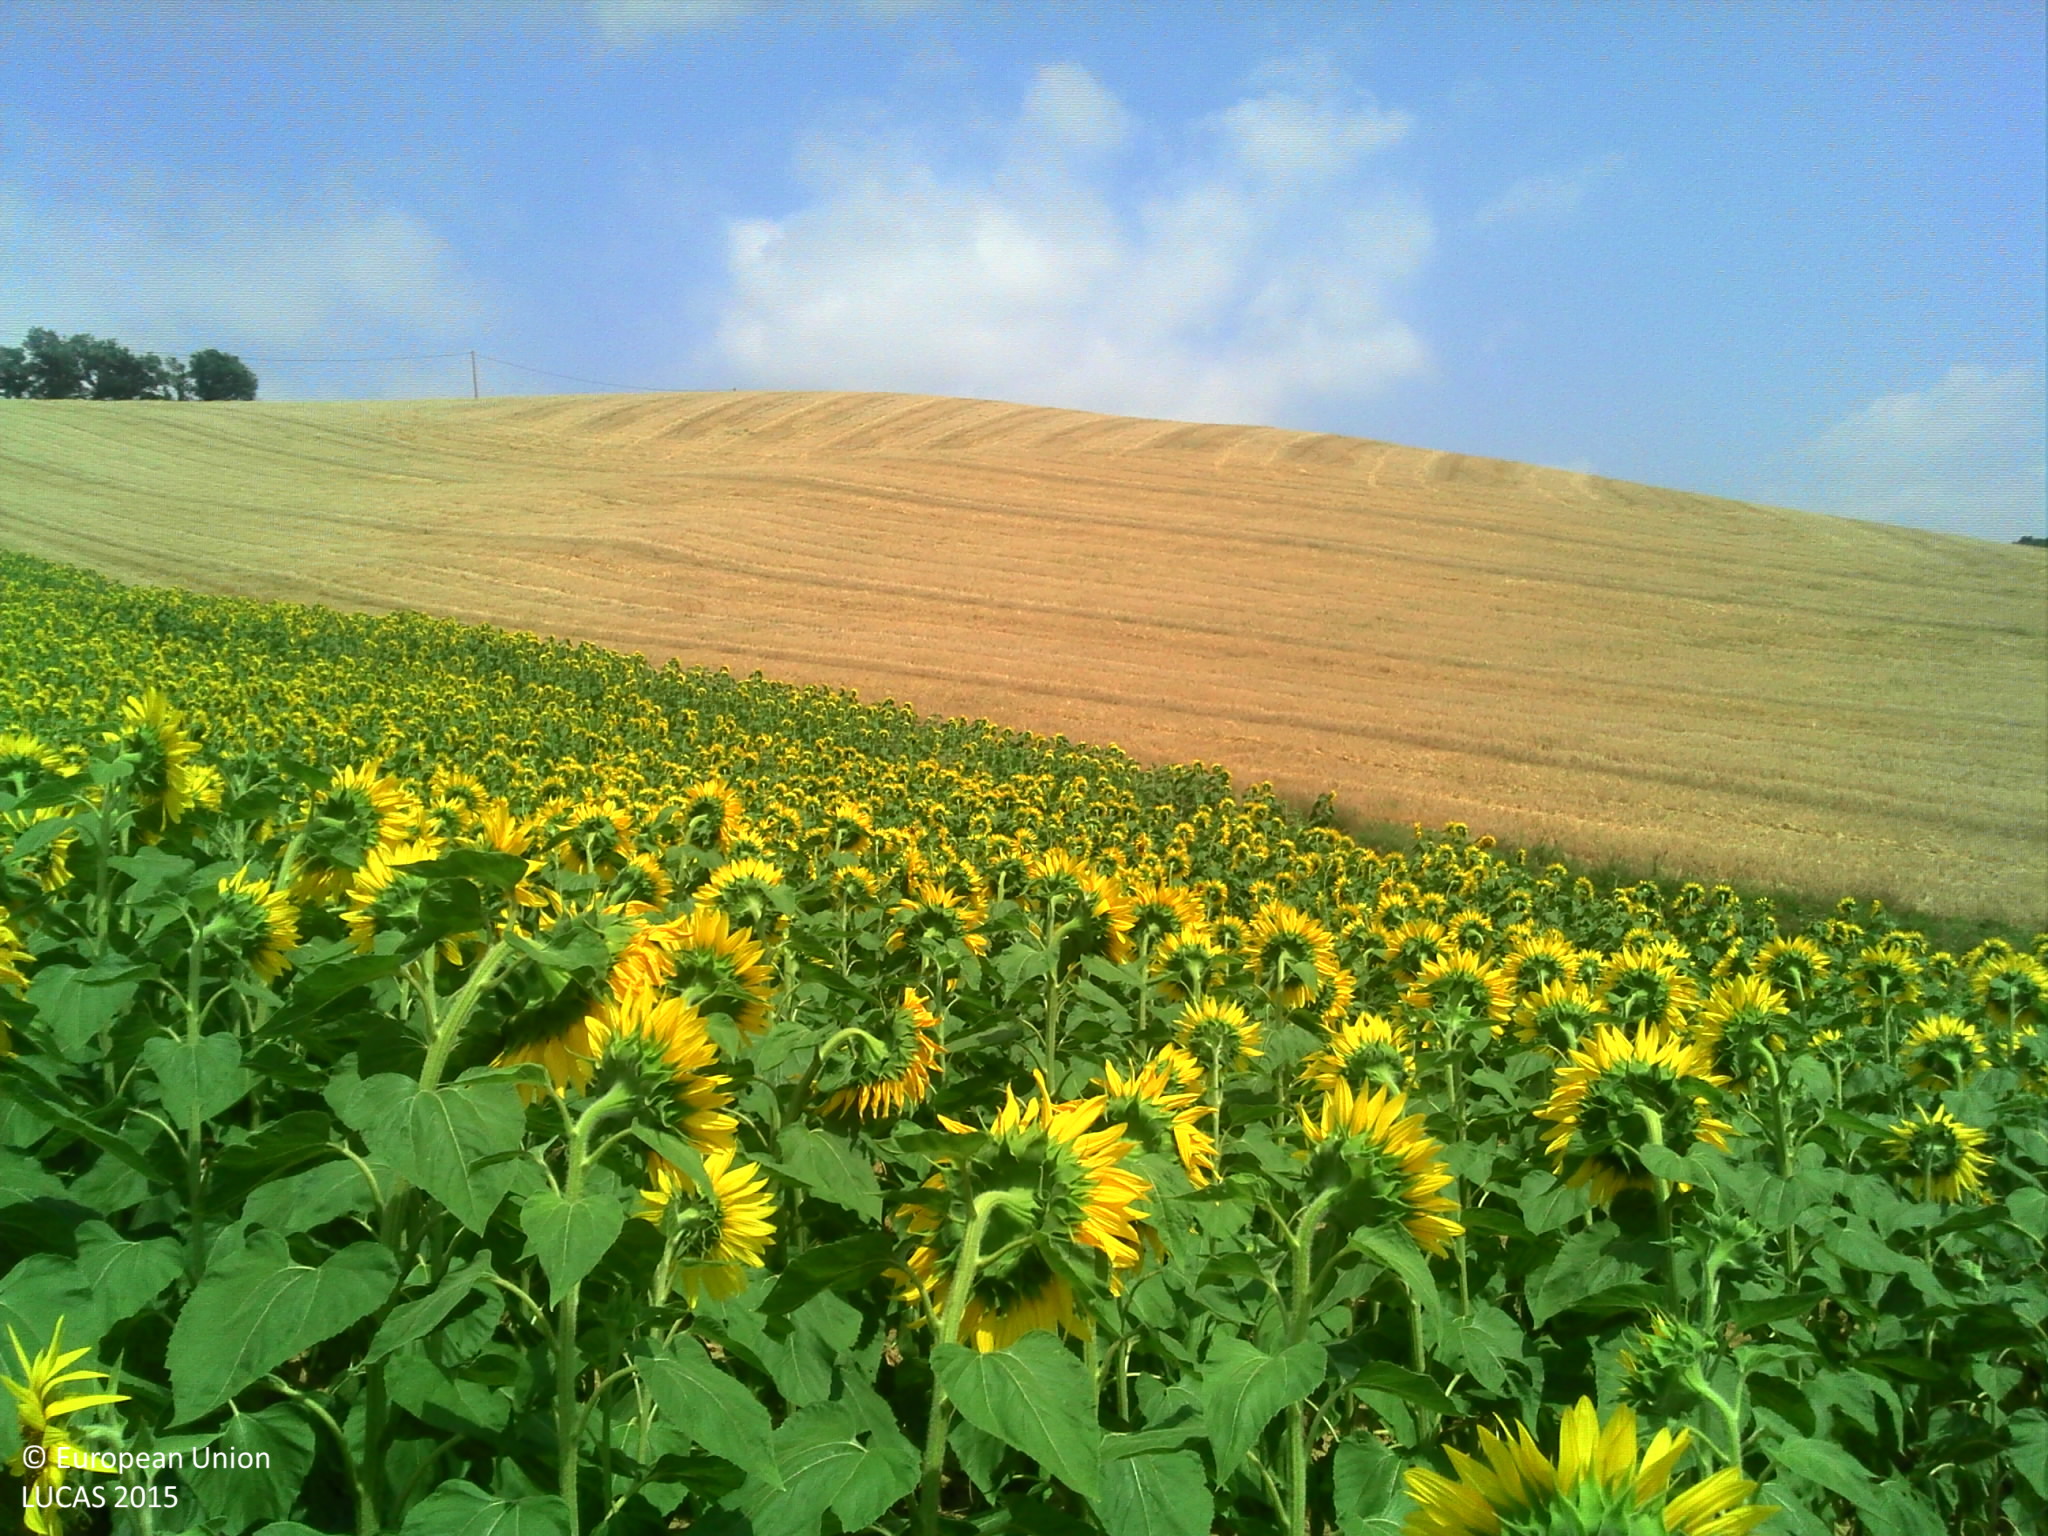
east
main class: Cropland
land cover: Sunflower
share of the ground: > 75 %
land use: Agriculture (excluding fallow land and kitchen gardens)
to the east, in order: Sunflower; Ditches and canals; Common wheat
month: July
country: FR
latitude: 43.3764
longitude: 0.9793
